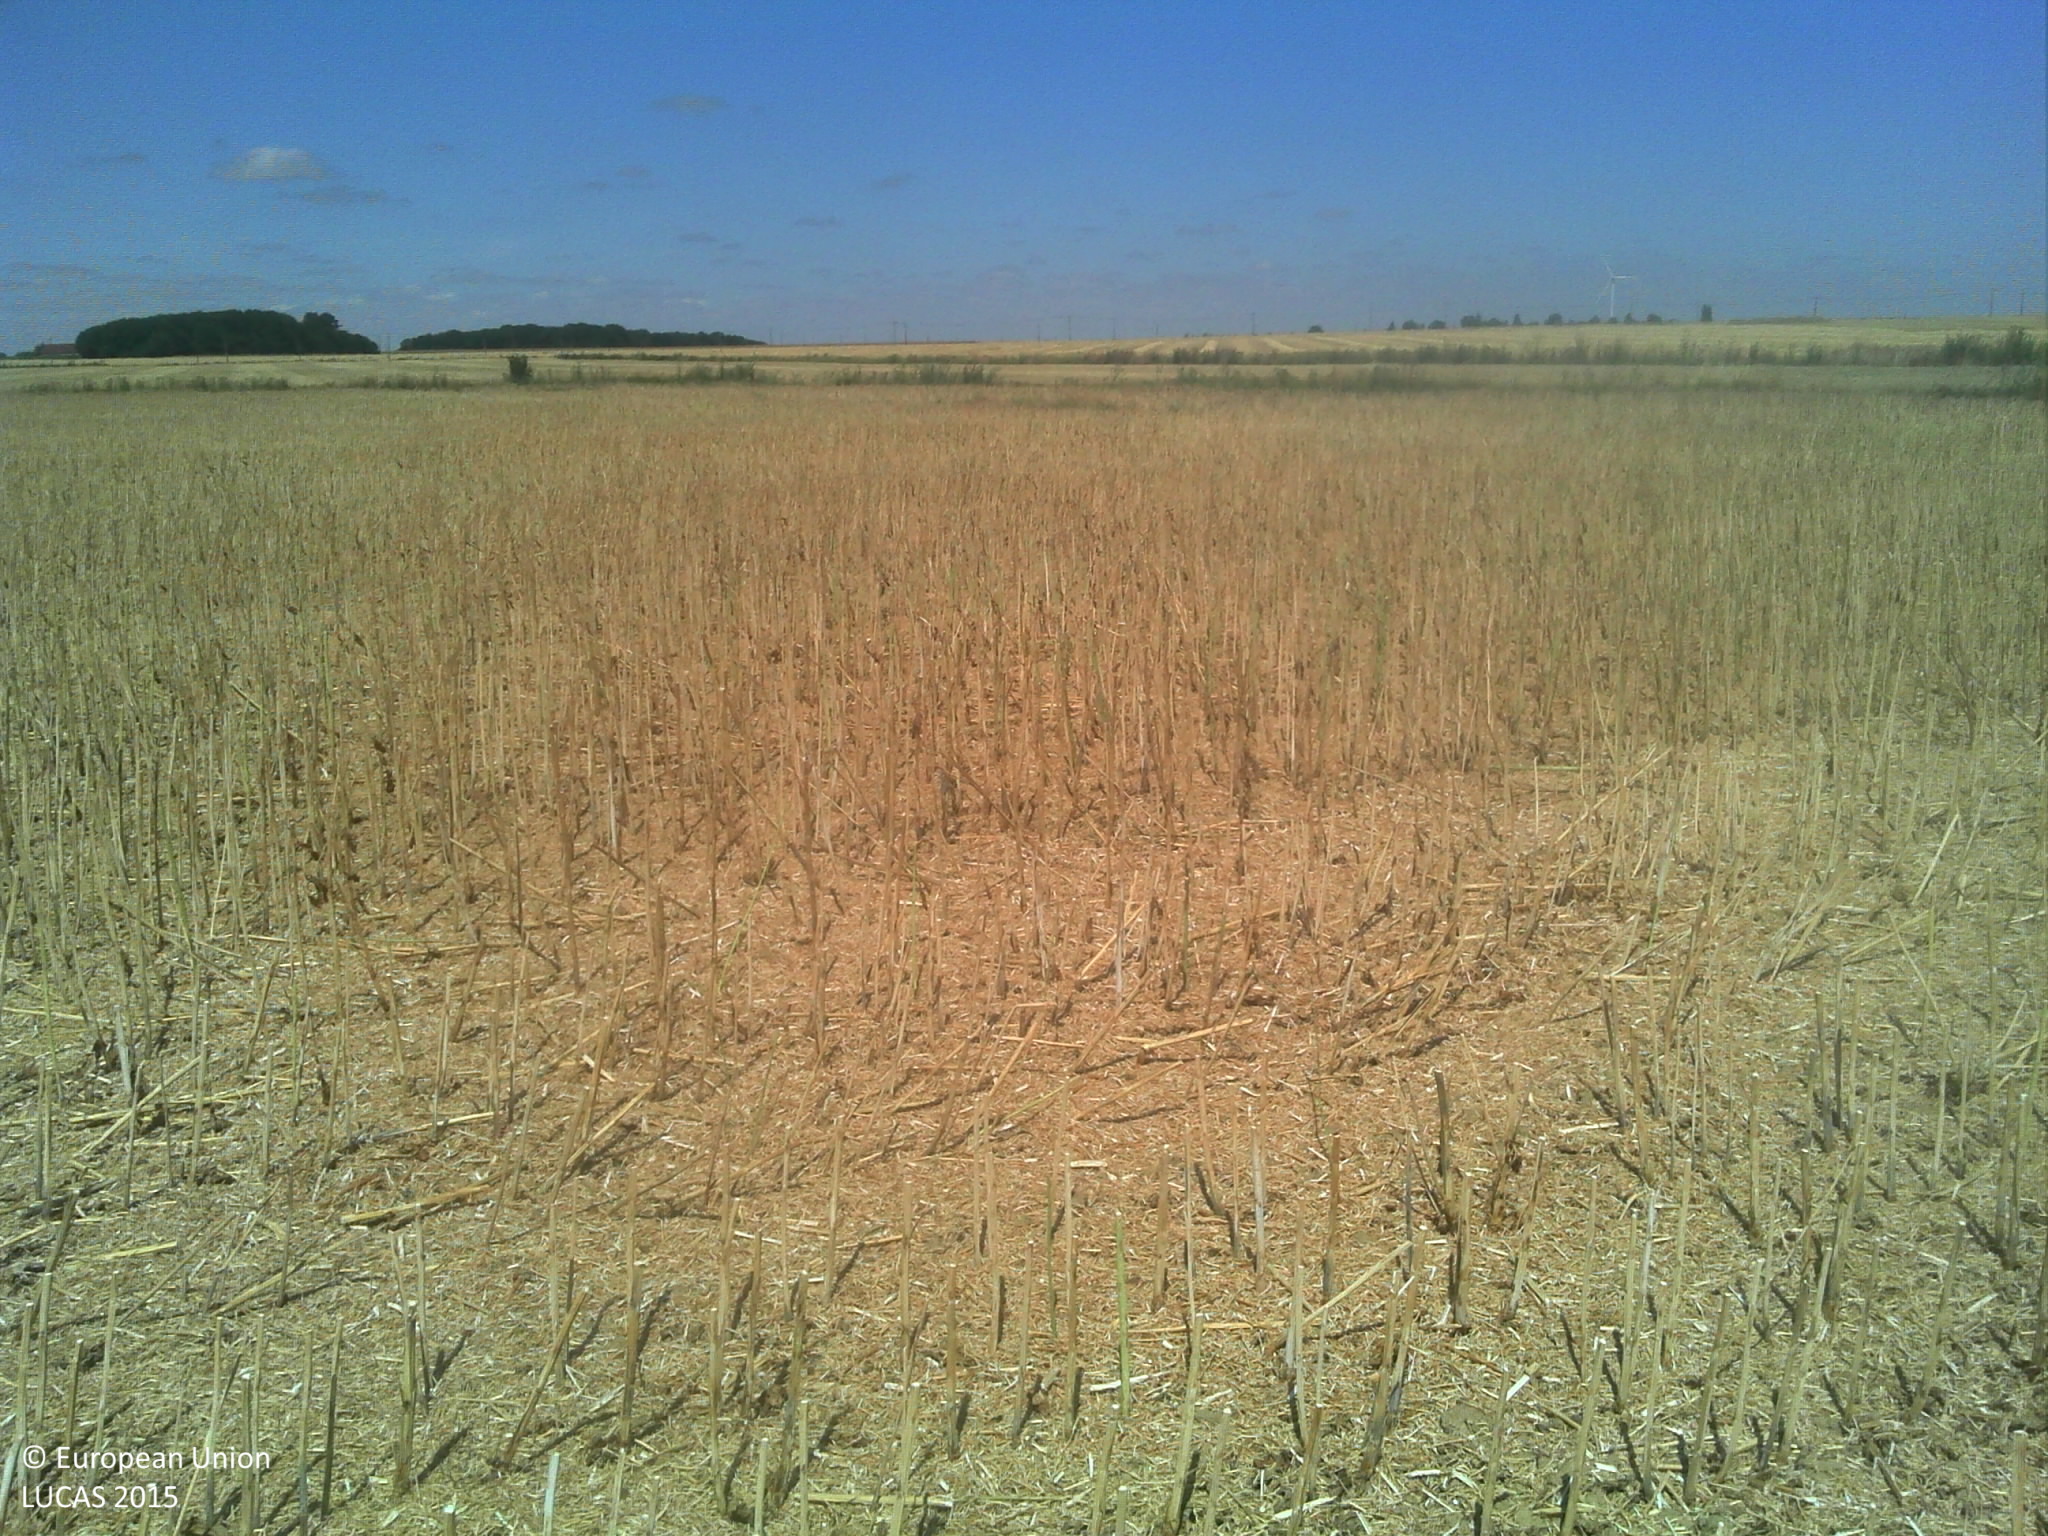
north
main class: Cropland
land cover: Rape and turnip rape
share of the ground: < 10 %
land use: Agriculture (excluding fallow land and kitchen gardens)
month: July
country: FR
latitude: 47.9152
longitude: 1.2993
